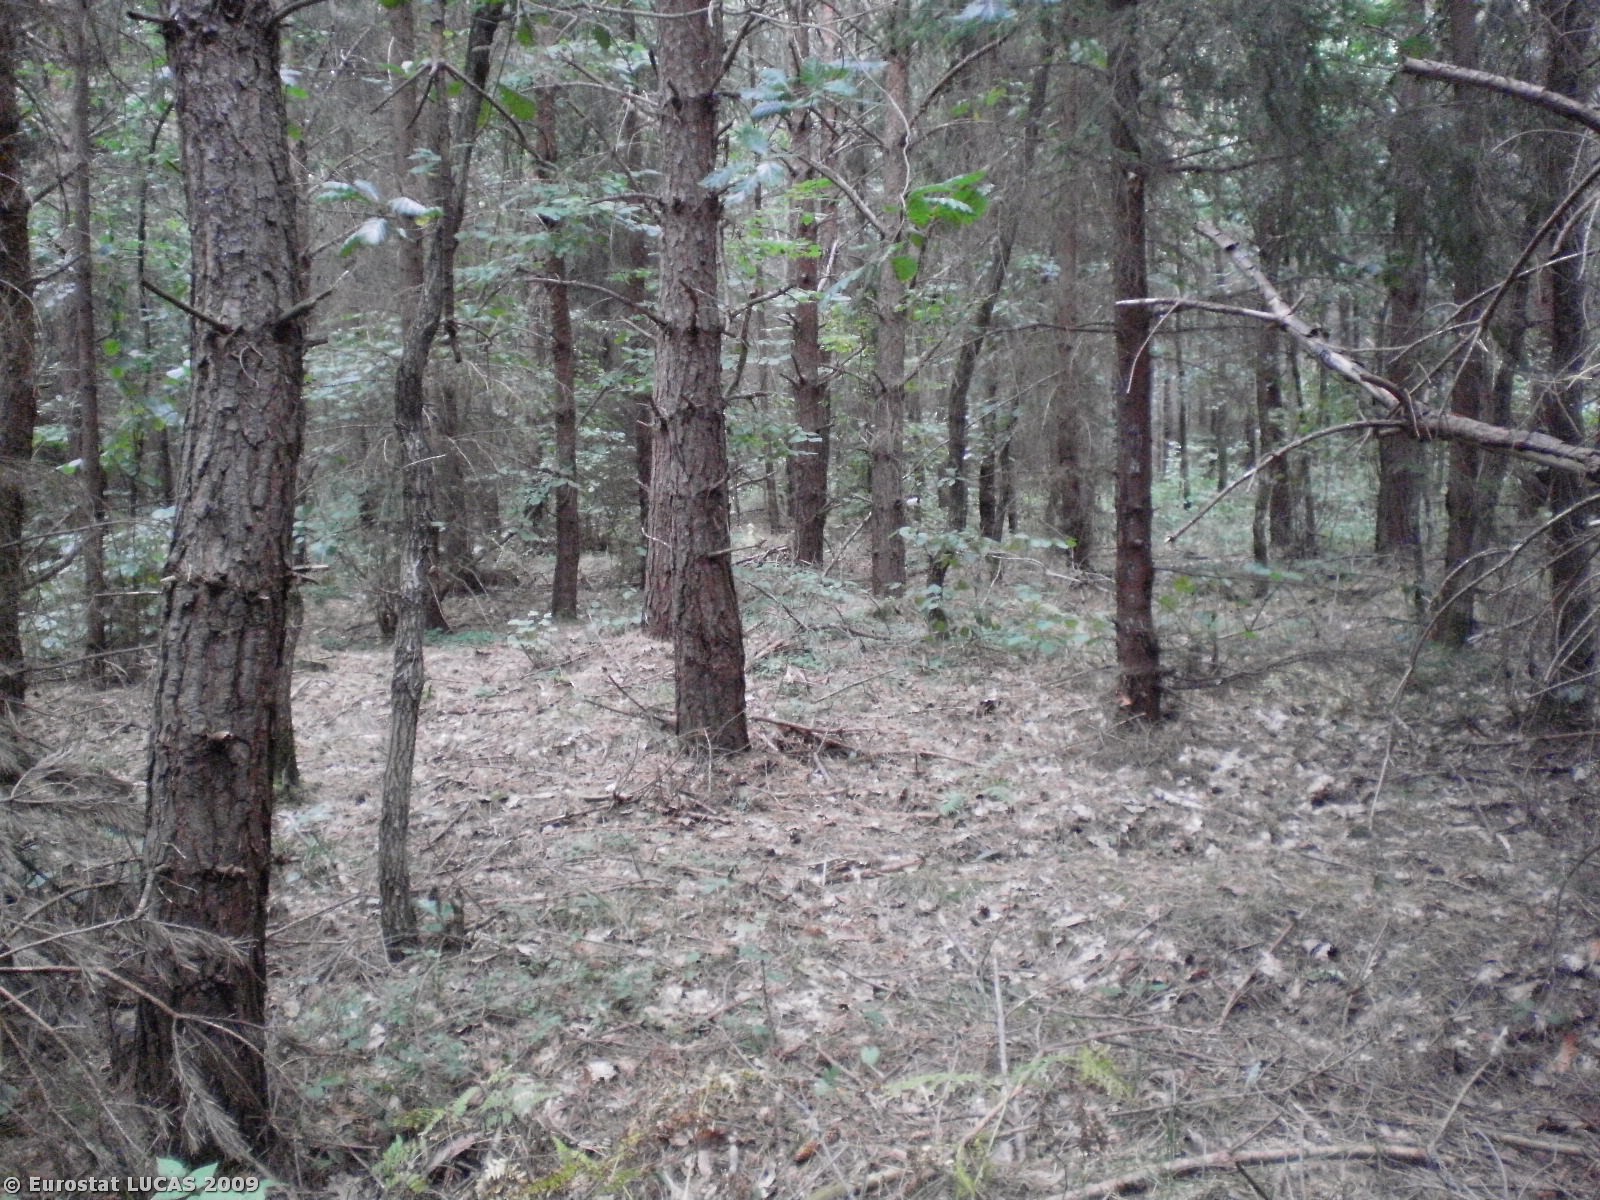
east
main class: Woodland
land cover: Coniferous woodland
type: hemiboreal forest and nemoral coniferous forest and mixed broadleaved-coniferous forest
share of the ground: > 75 %
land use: Forestry
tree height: > 5 m
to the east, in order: Coniferous woodland
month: September
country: PL
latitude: 53.7687
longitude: 21.4120
